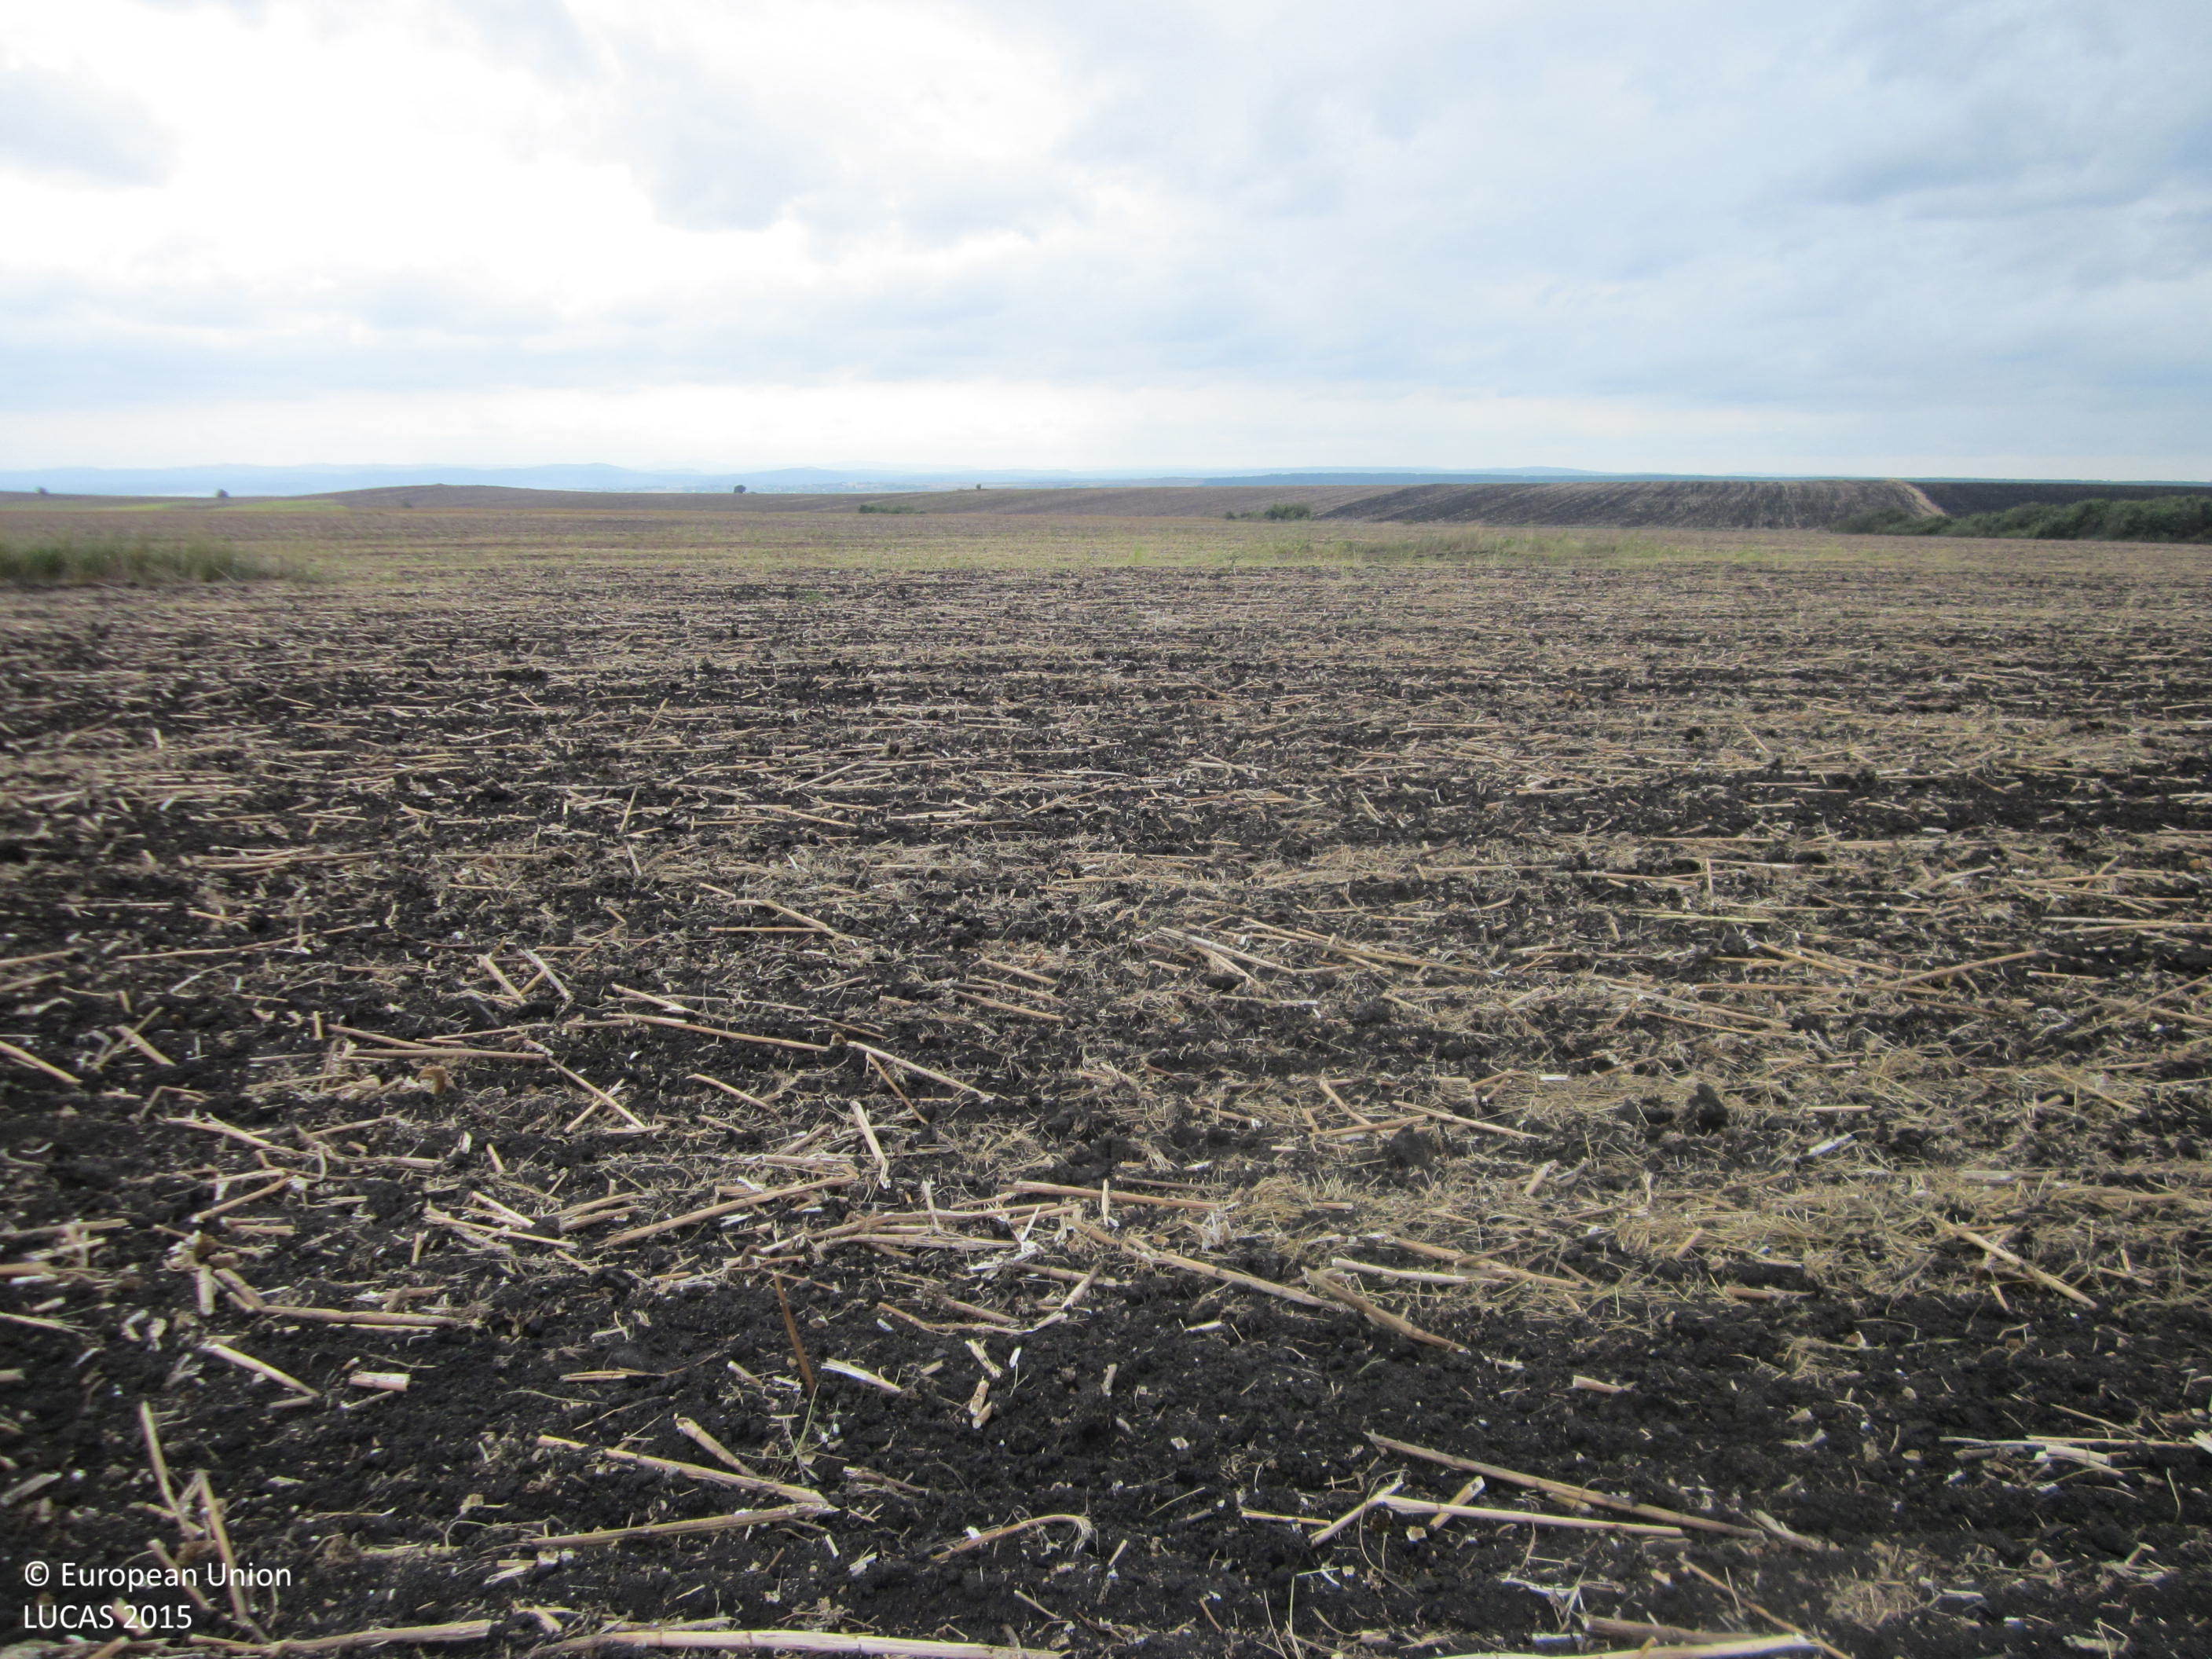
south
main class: Cropland
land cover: Sunflower
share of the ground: 25 - 50 %
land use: Agriculture (excluding fallow land and kitchen gardens)
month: September
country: BG
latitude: 42.4652
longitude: 27.2715
